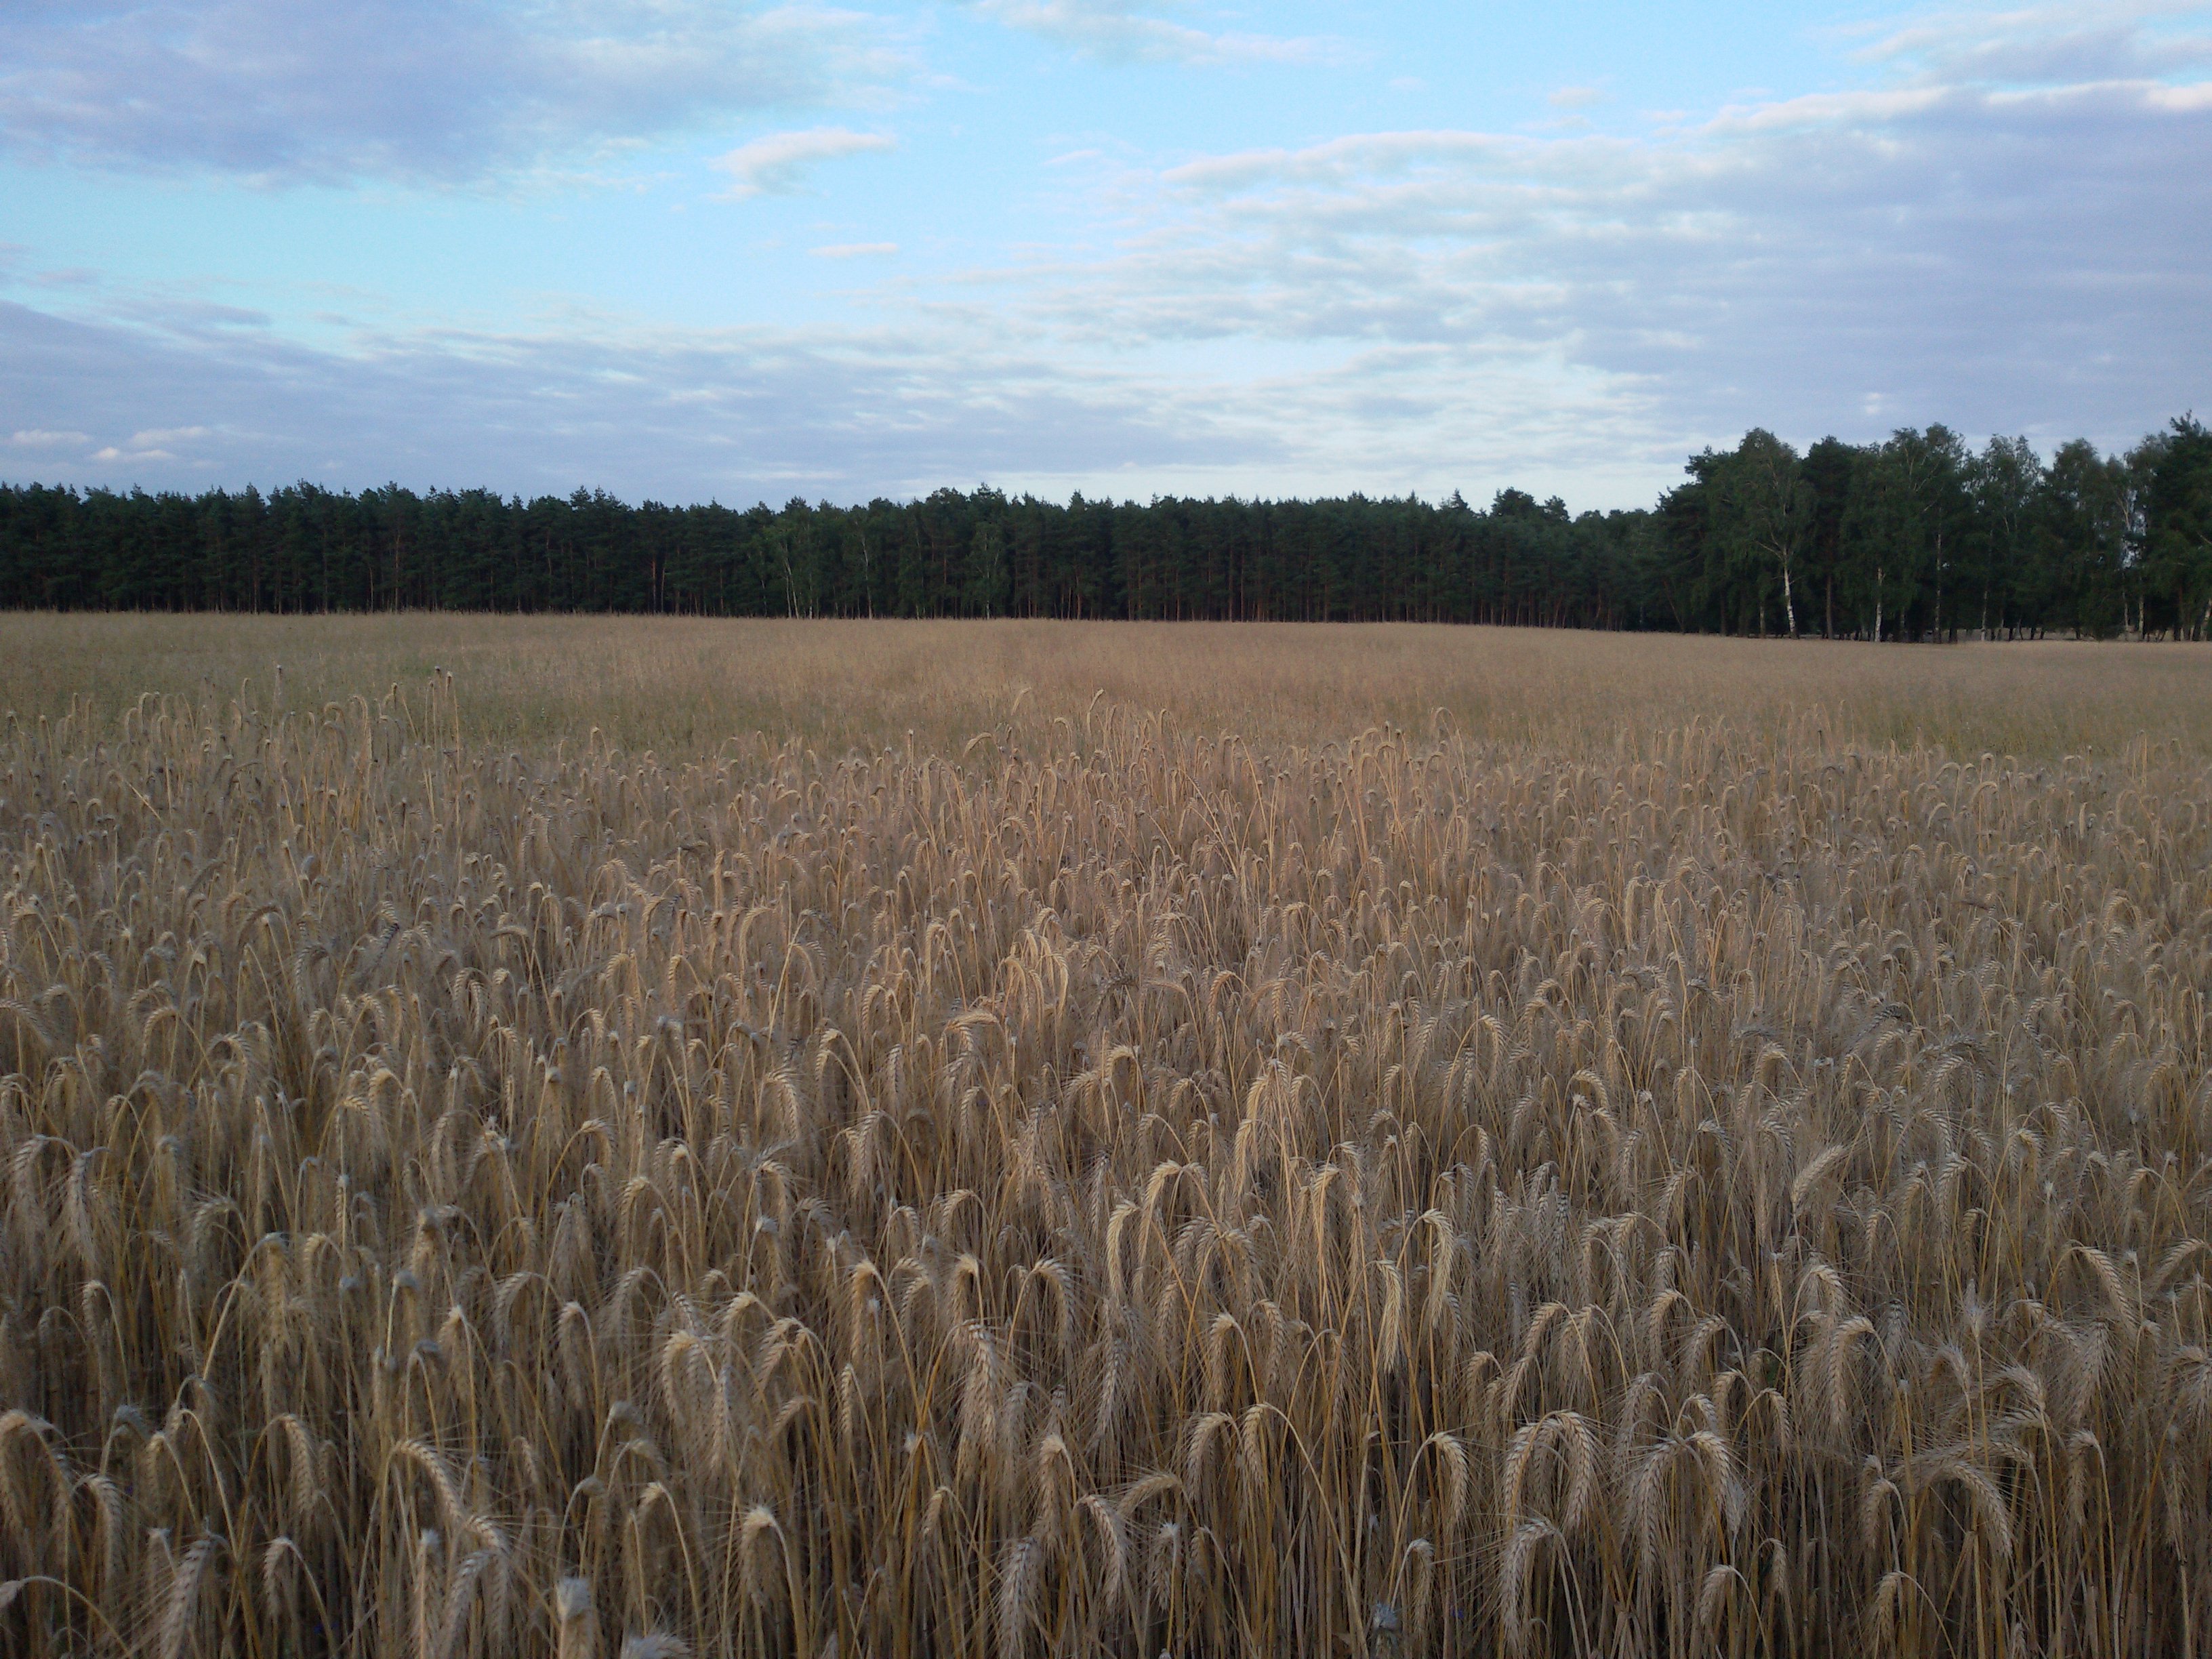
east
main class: Cropland
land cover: Triticale
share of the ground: > 75 %
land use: Agriculture (excluding fallow land and kitchen gardens)
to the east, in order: Triticale; Barley
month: July
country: PL
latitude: 52.8026
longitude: 16.9959
